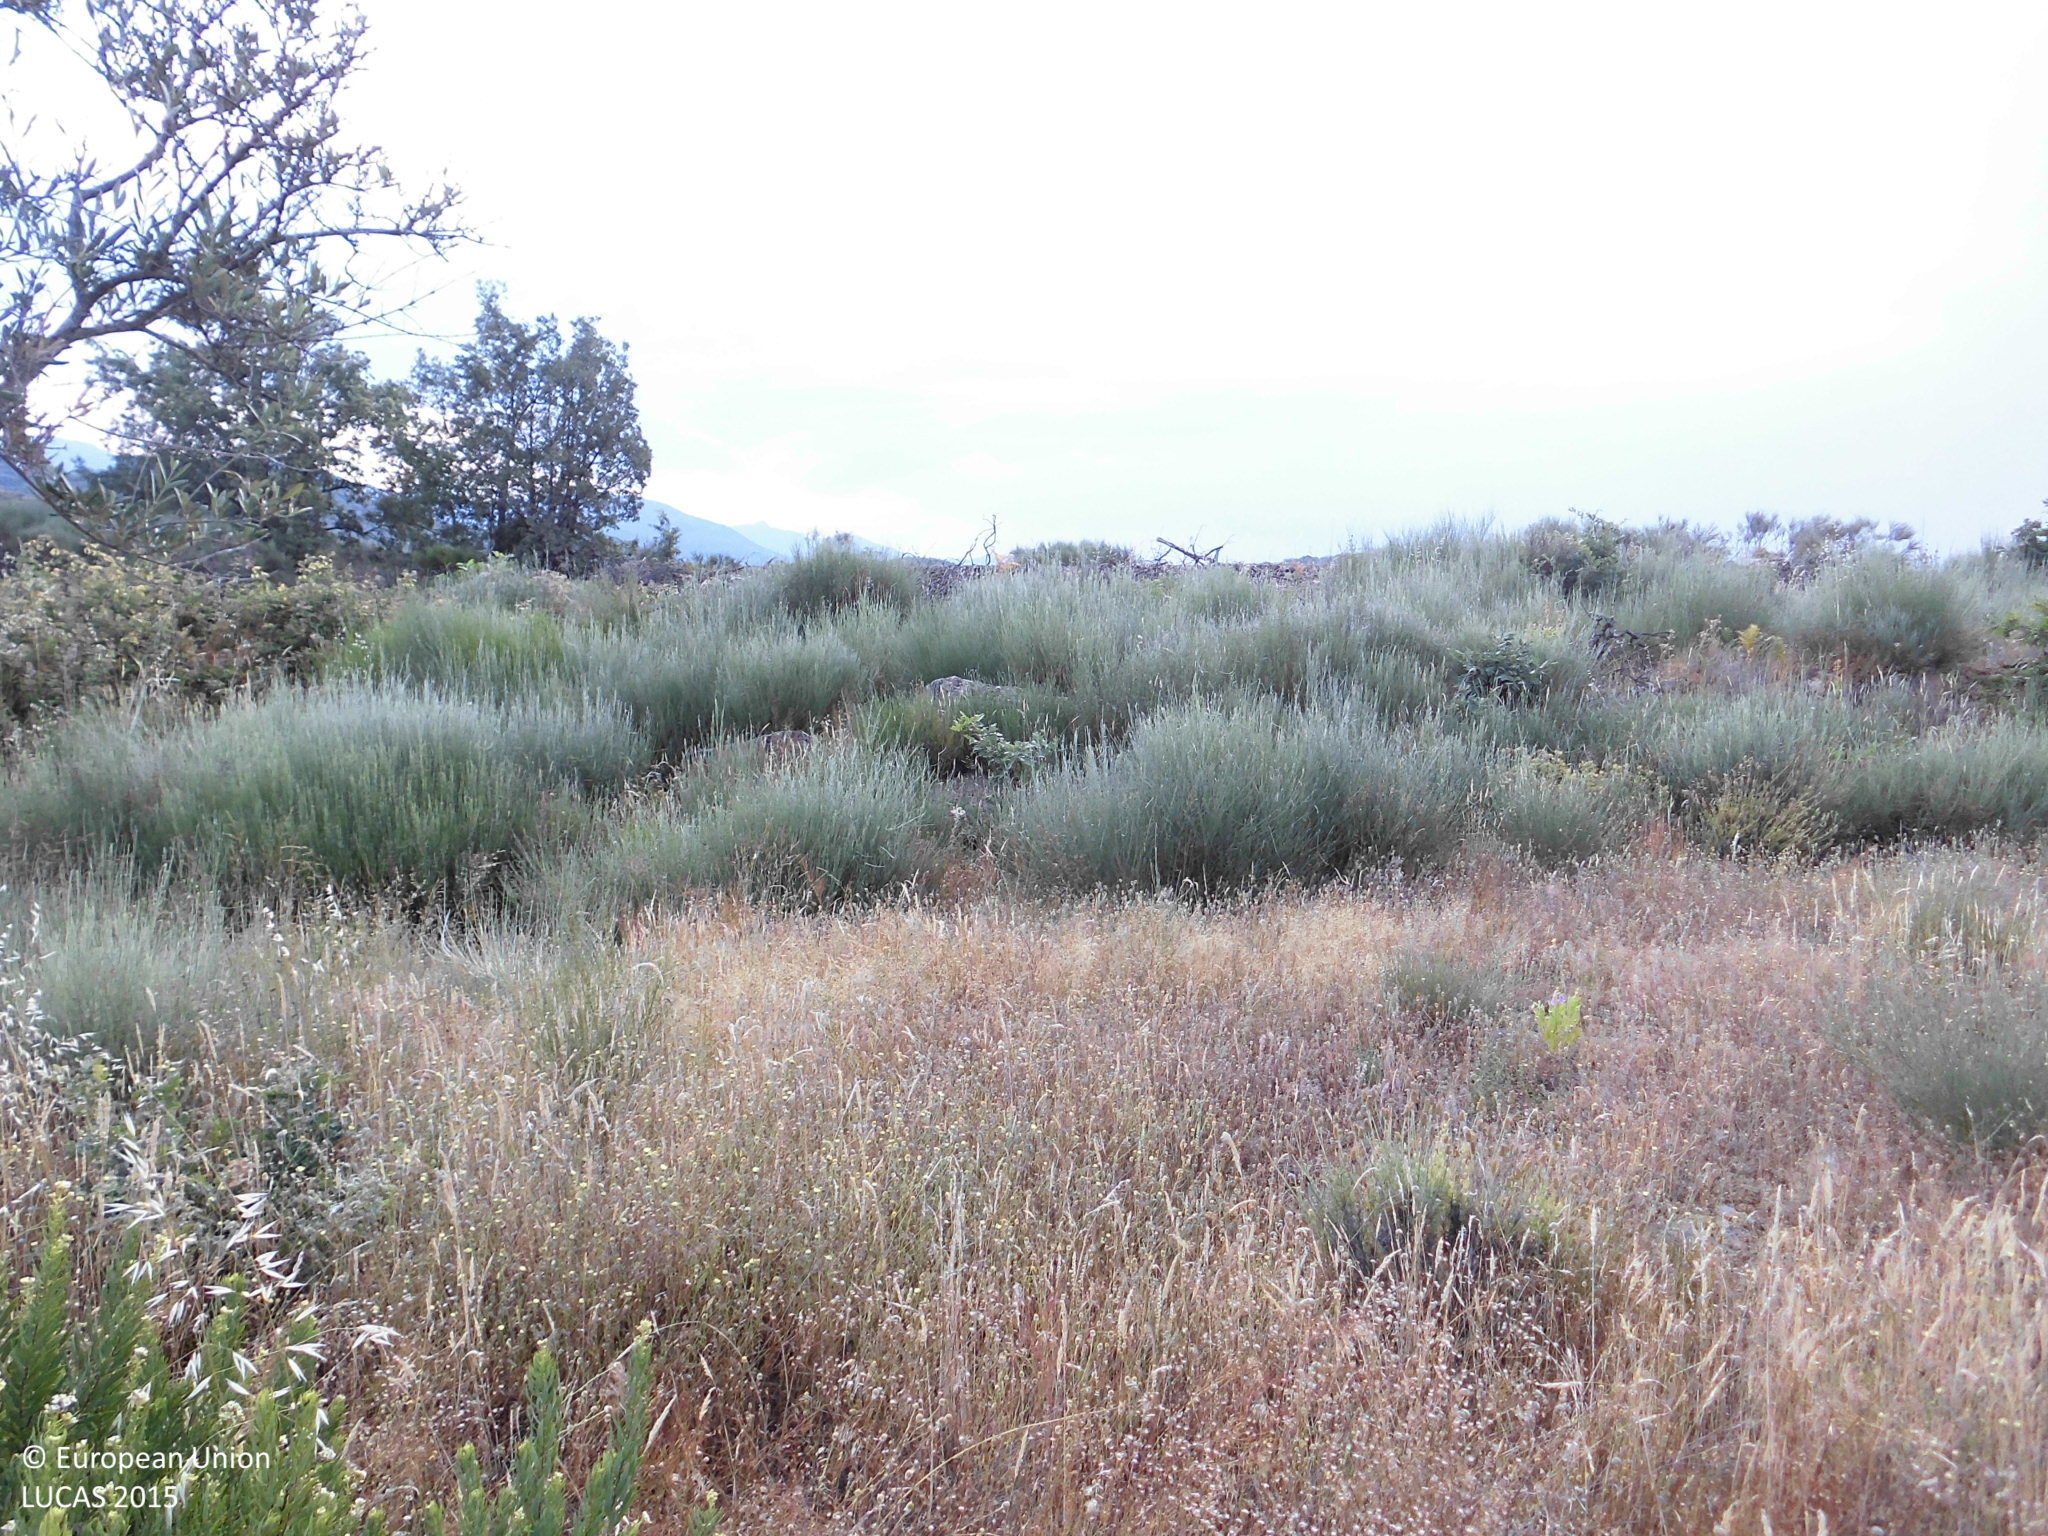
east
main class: Cropland
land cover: Olive groves
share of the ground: < 10 %
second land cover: Spontaneously vegetated surfaces
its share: > 75 %
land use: Agriculture (excluding fallow land and kitchen gardens)
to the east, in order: Olive groves; Spontaneously vegetated surfaces; Dry stone walls; Shrubland with sparse tree cover; Tracks; Shrubland with sparse tree cover; Tracks; Broadleaved woodland; Shrubland with sparse tree cover
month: June
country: ES
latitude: 40.0976
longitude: -5.7011
